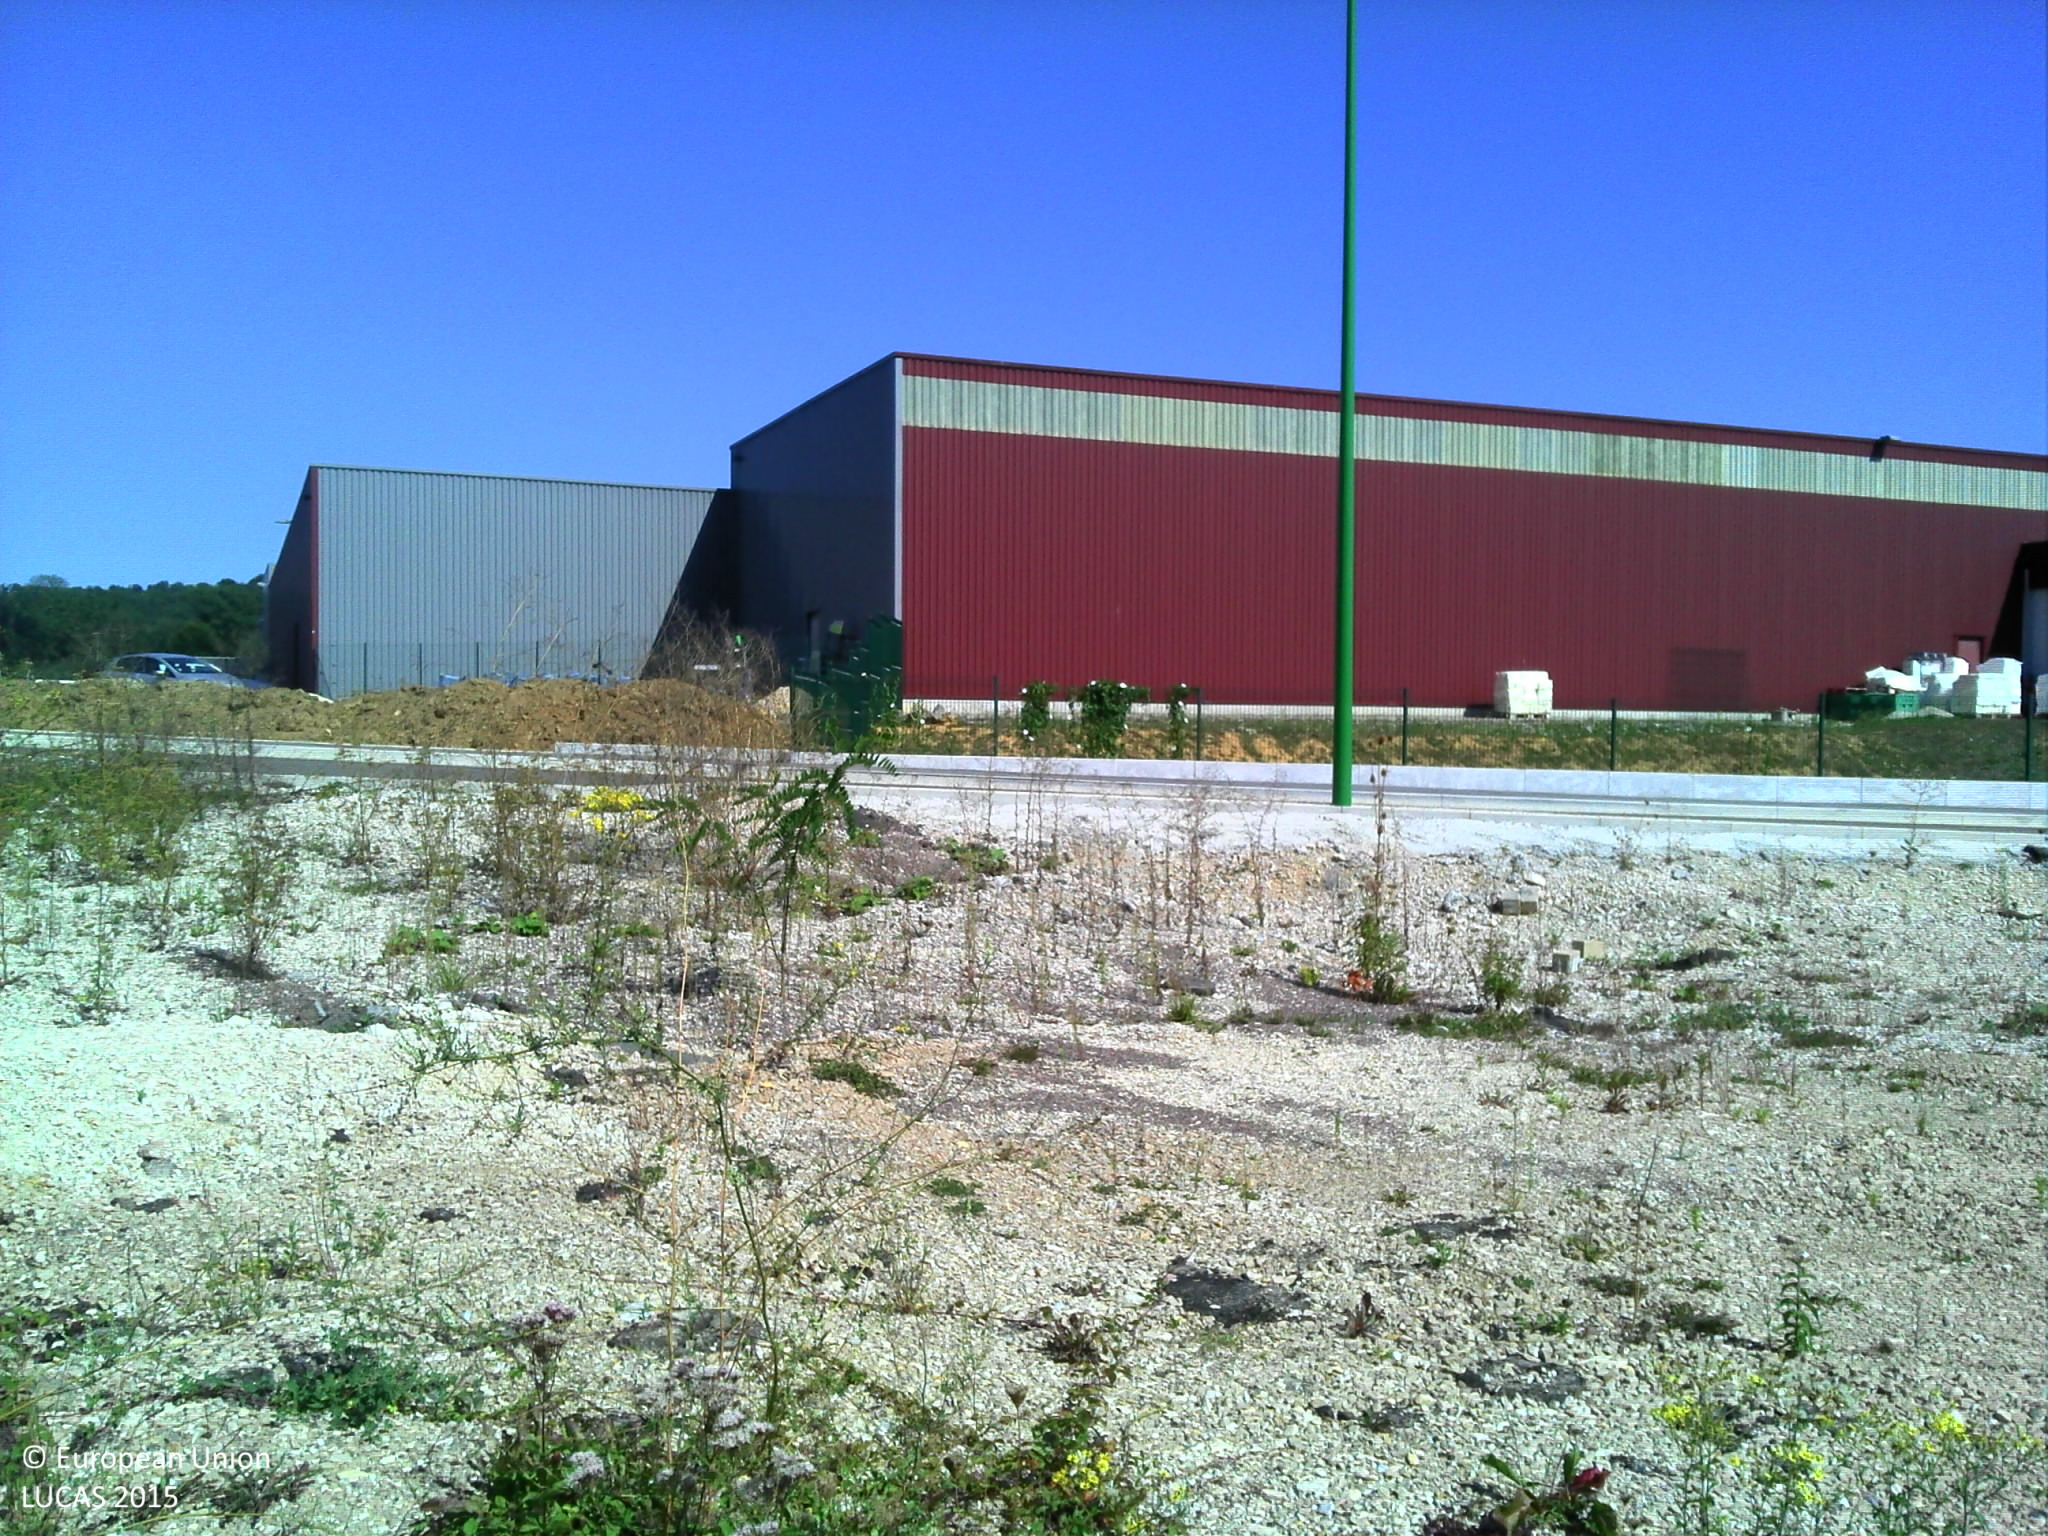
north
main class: Grassland
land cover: Spontaneously vegetated surfaces
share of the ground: > 75 %
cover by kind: herbaceous plants 95 %, shrubs 5 %
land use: Commerce
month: September
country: FR
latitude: 47.2717
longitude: 6.1024
